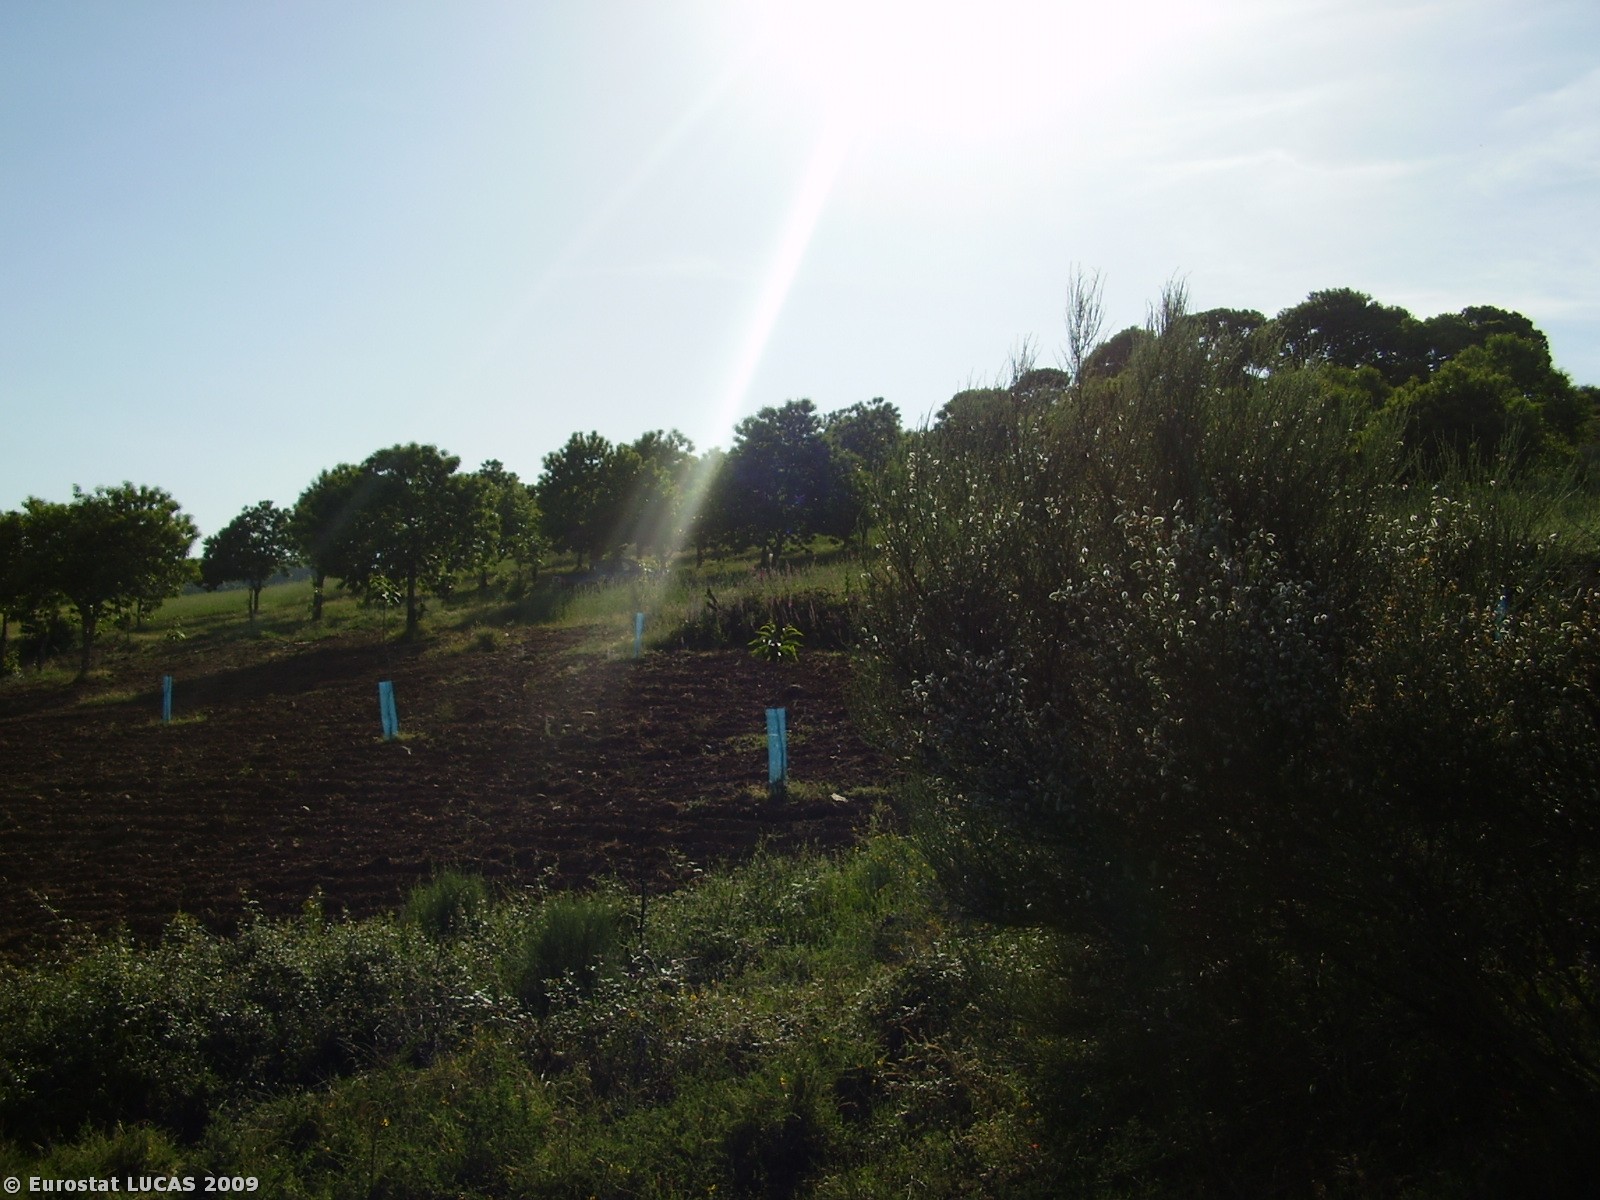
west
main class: Shrubland
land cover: Shrubland without tree cover
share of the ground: > 75 %
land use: Nature reserves
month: June
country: PT
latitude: 41.8757
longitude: -6.9519
